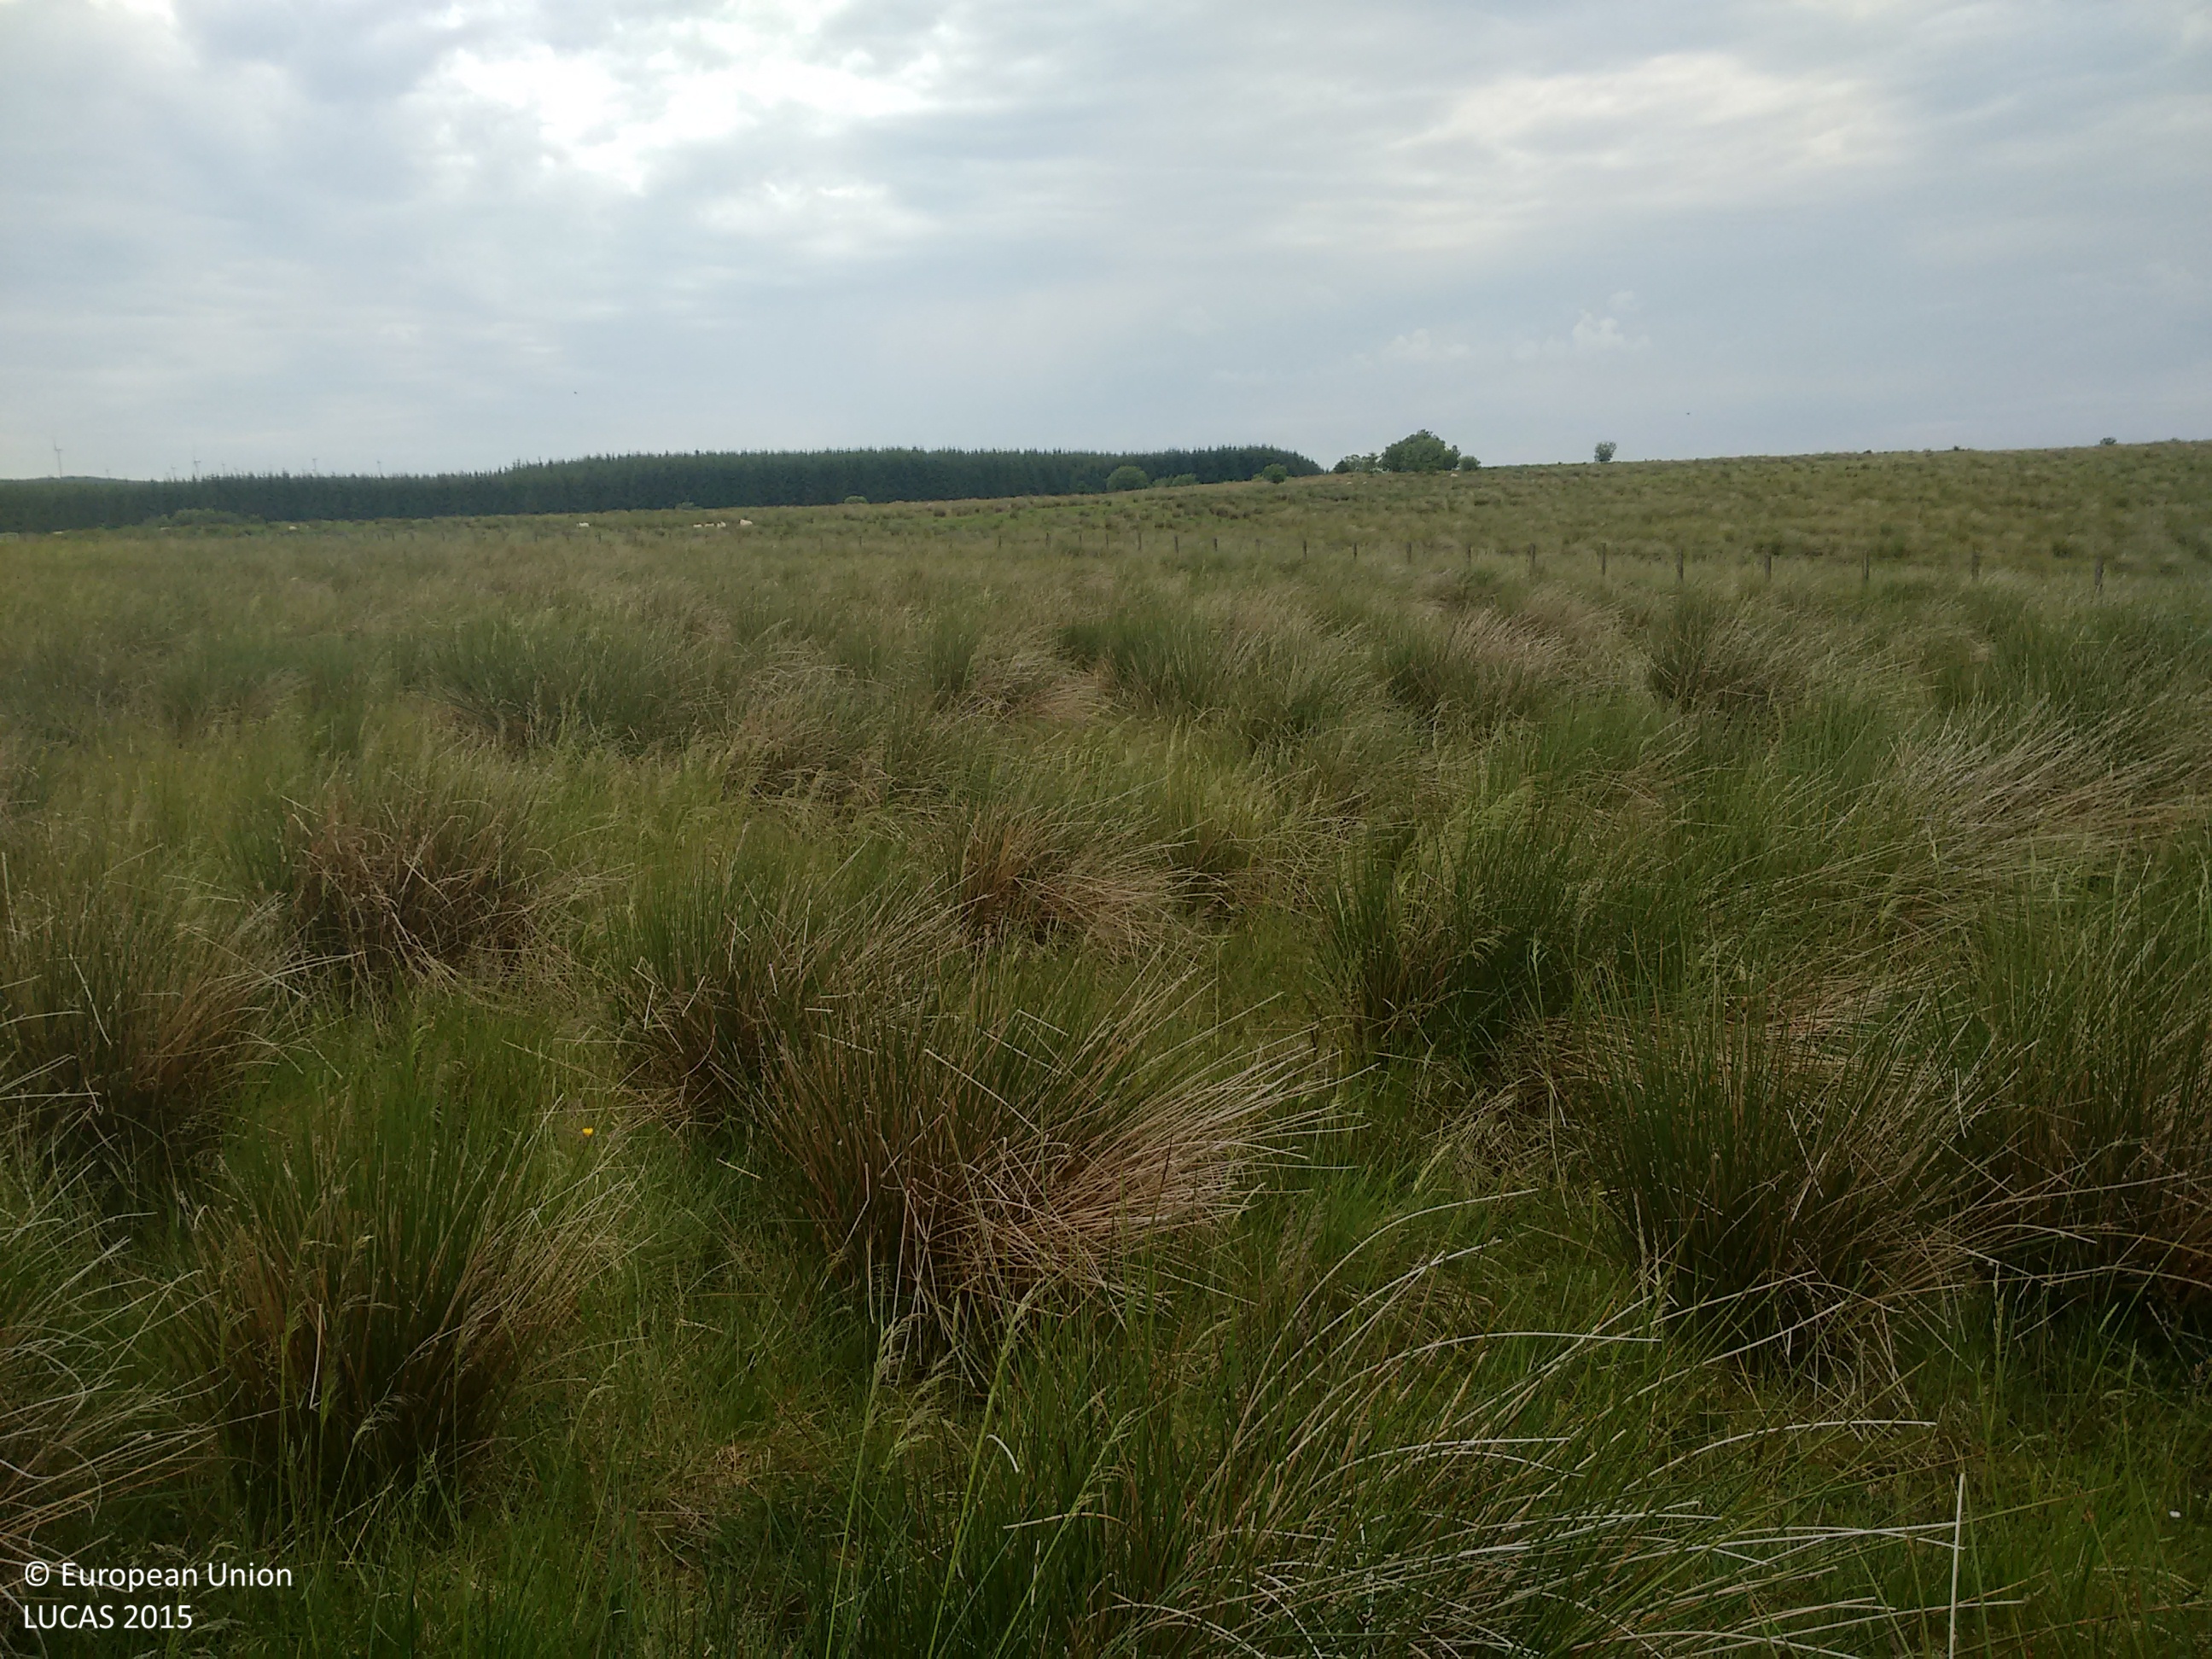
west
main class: Grassland
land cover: Grassland without tree/shrub cover
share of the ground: > 75 %
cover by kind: herbaceous plants 75 %, lichens and mosses 25 %
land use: Agriculture (excluding fallow land and kitchen gardens)
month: July
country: GB
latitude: 55.5757
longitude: -3.8695
